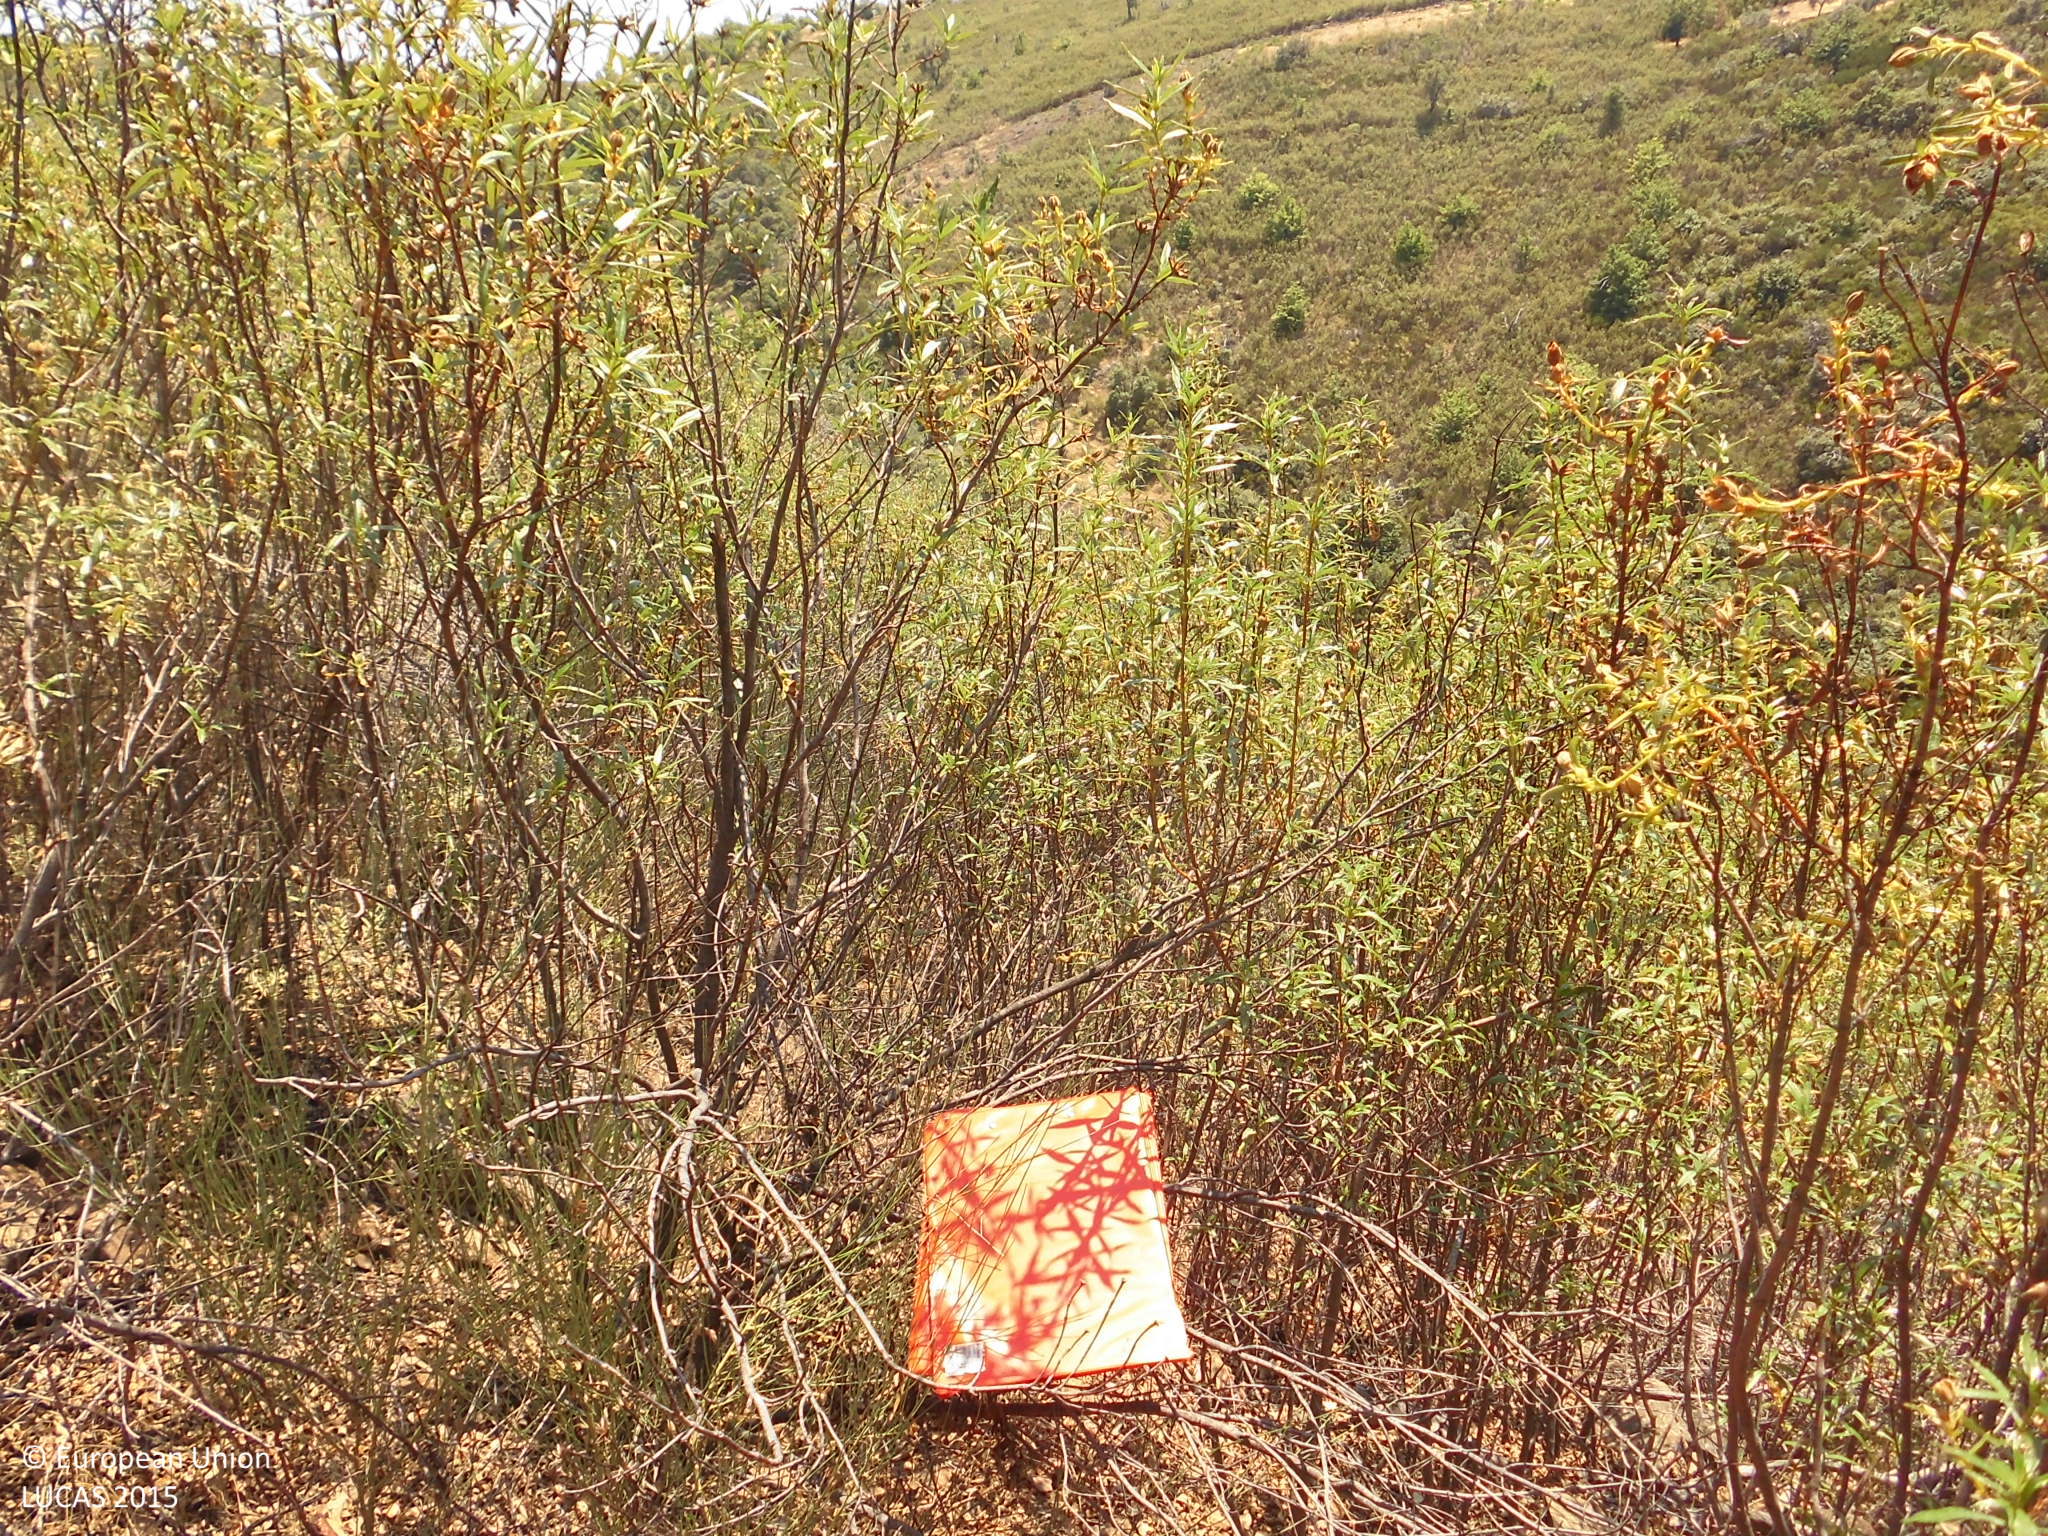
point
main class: Shrubland
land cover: Shrubland without tree cover
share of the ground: > 75 %
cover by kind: shrubs 100 %
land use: Semi-natural and natural areas not in use
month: June
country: ES
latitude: 39.5753
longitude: -5.4066
